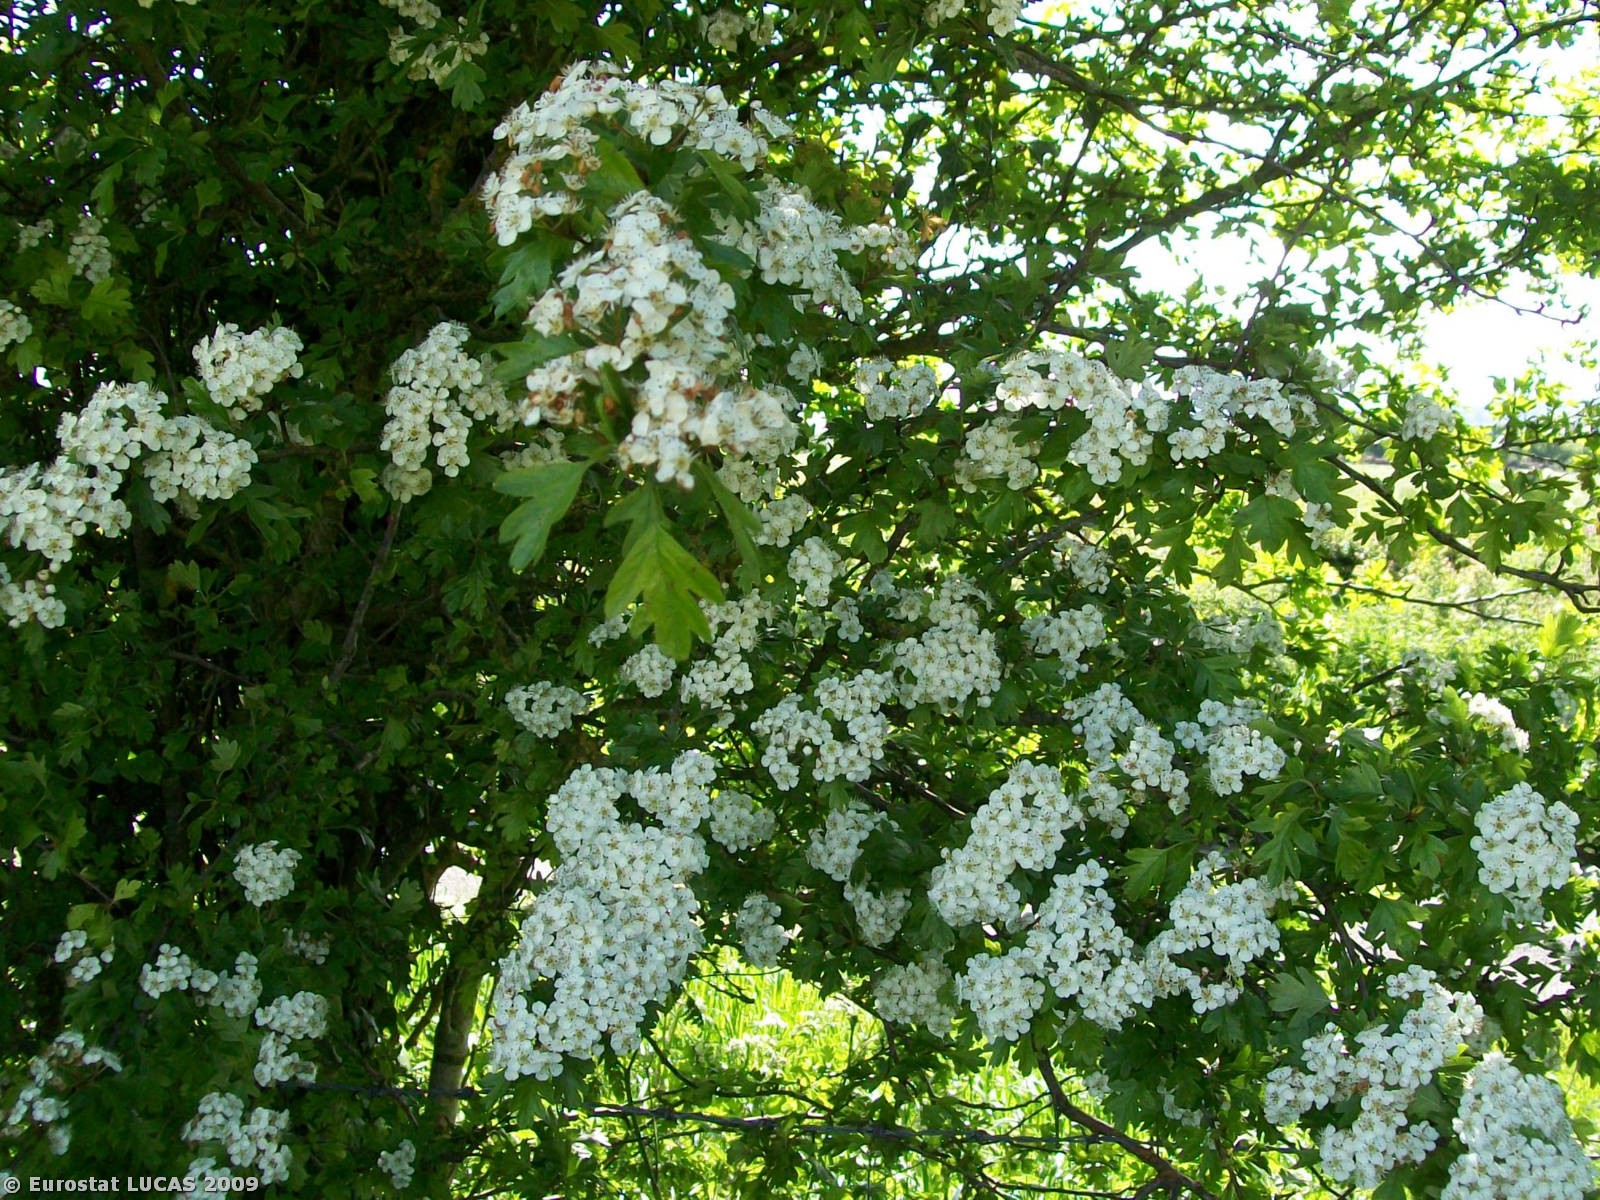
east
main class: Cropland
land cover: Rape and turnip rape
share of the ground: > 75 %
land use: Agriculture (excluding fallow land and kitchen gardens)
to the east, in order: Rape and turnip rape; Grass margins; Fences; Abandoned hedges; Grass margins; Paved roads, cycling and walking lanes; Managed hedges; Fences; Spontaneously vegetated surfaces; Abandoned hedges; Fences; Spontaneously vegetated surfaces; Grassland without tree/shrub cover
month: May
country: GB
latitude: 51.0922
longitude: -2.1833
